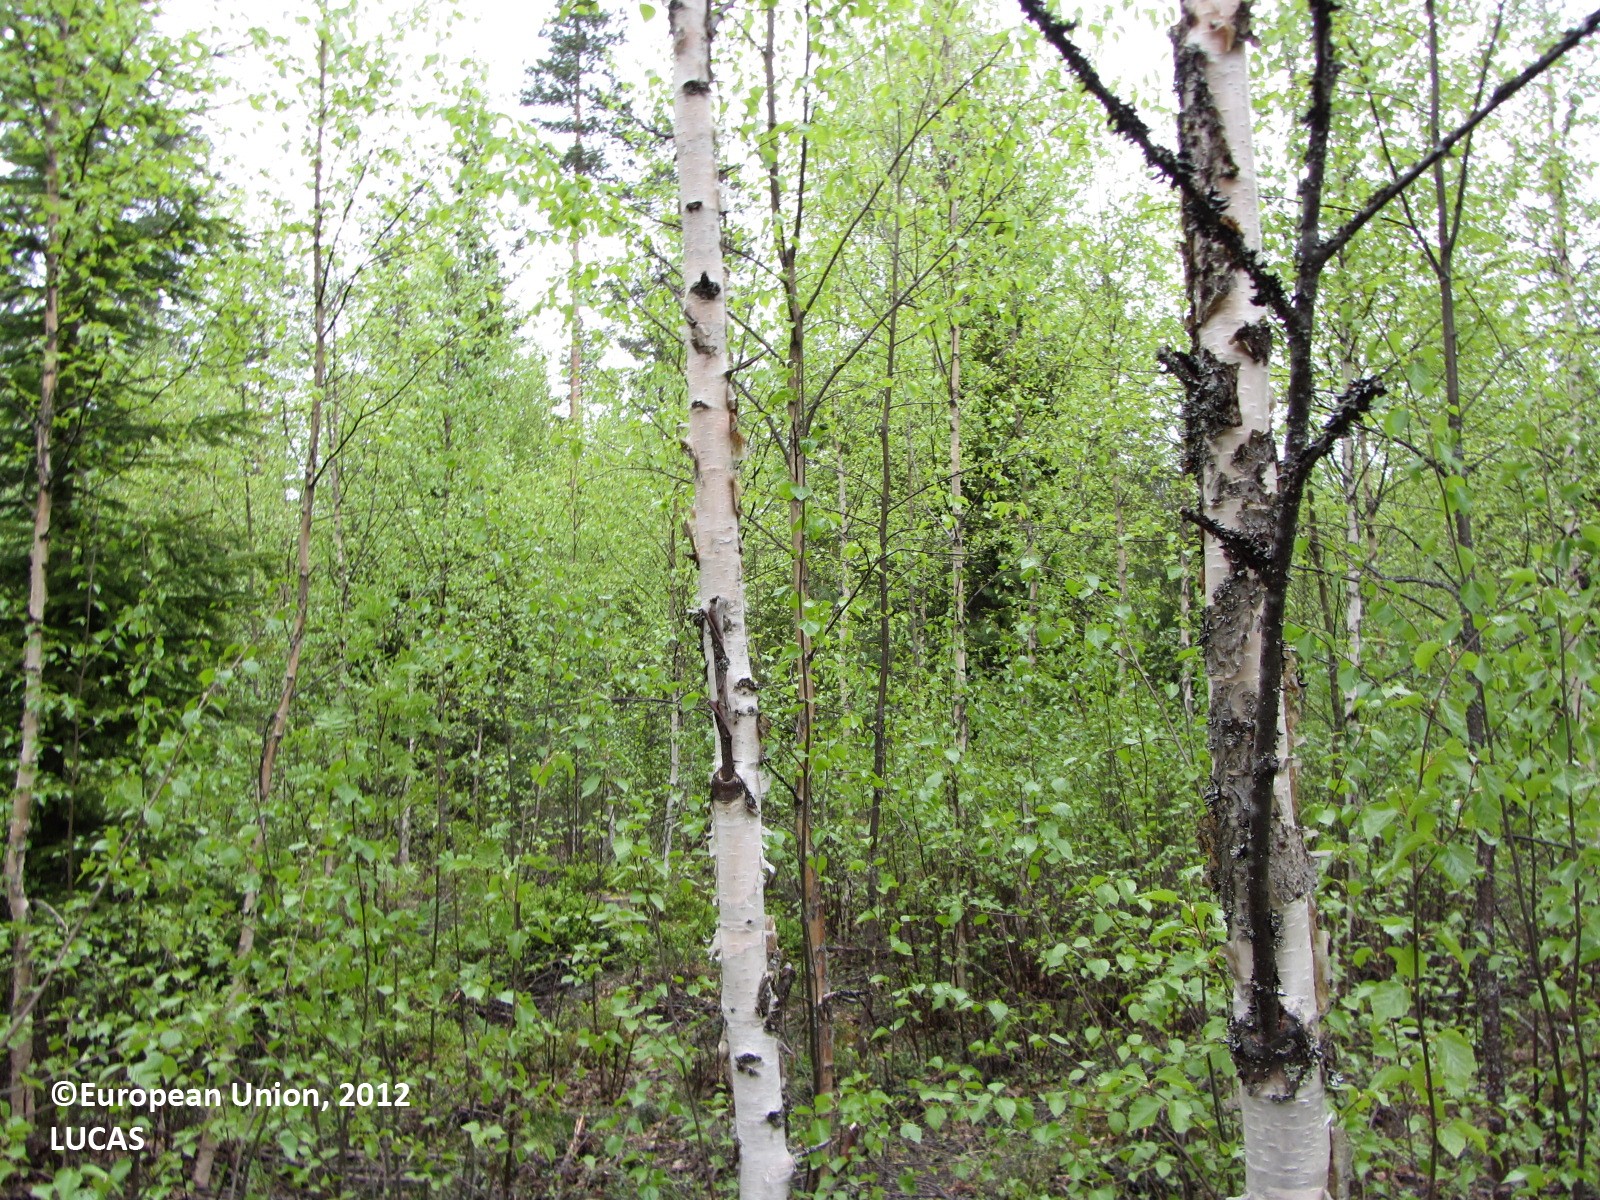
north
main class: Woodland
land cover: Broadleaved woodland
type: hemiboreal forest and nemoral coniferous forest and mixed broadleaved-coniferous forest
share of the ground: > 75 %
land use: Forestry
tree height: > 5 m
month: May
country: FI
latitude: 62.4092
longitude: 25.3403
